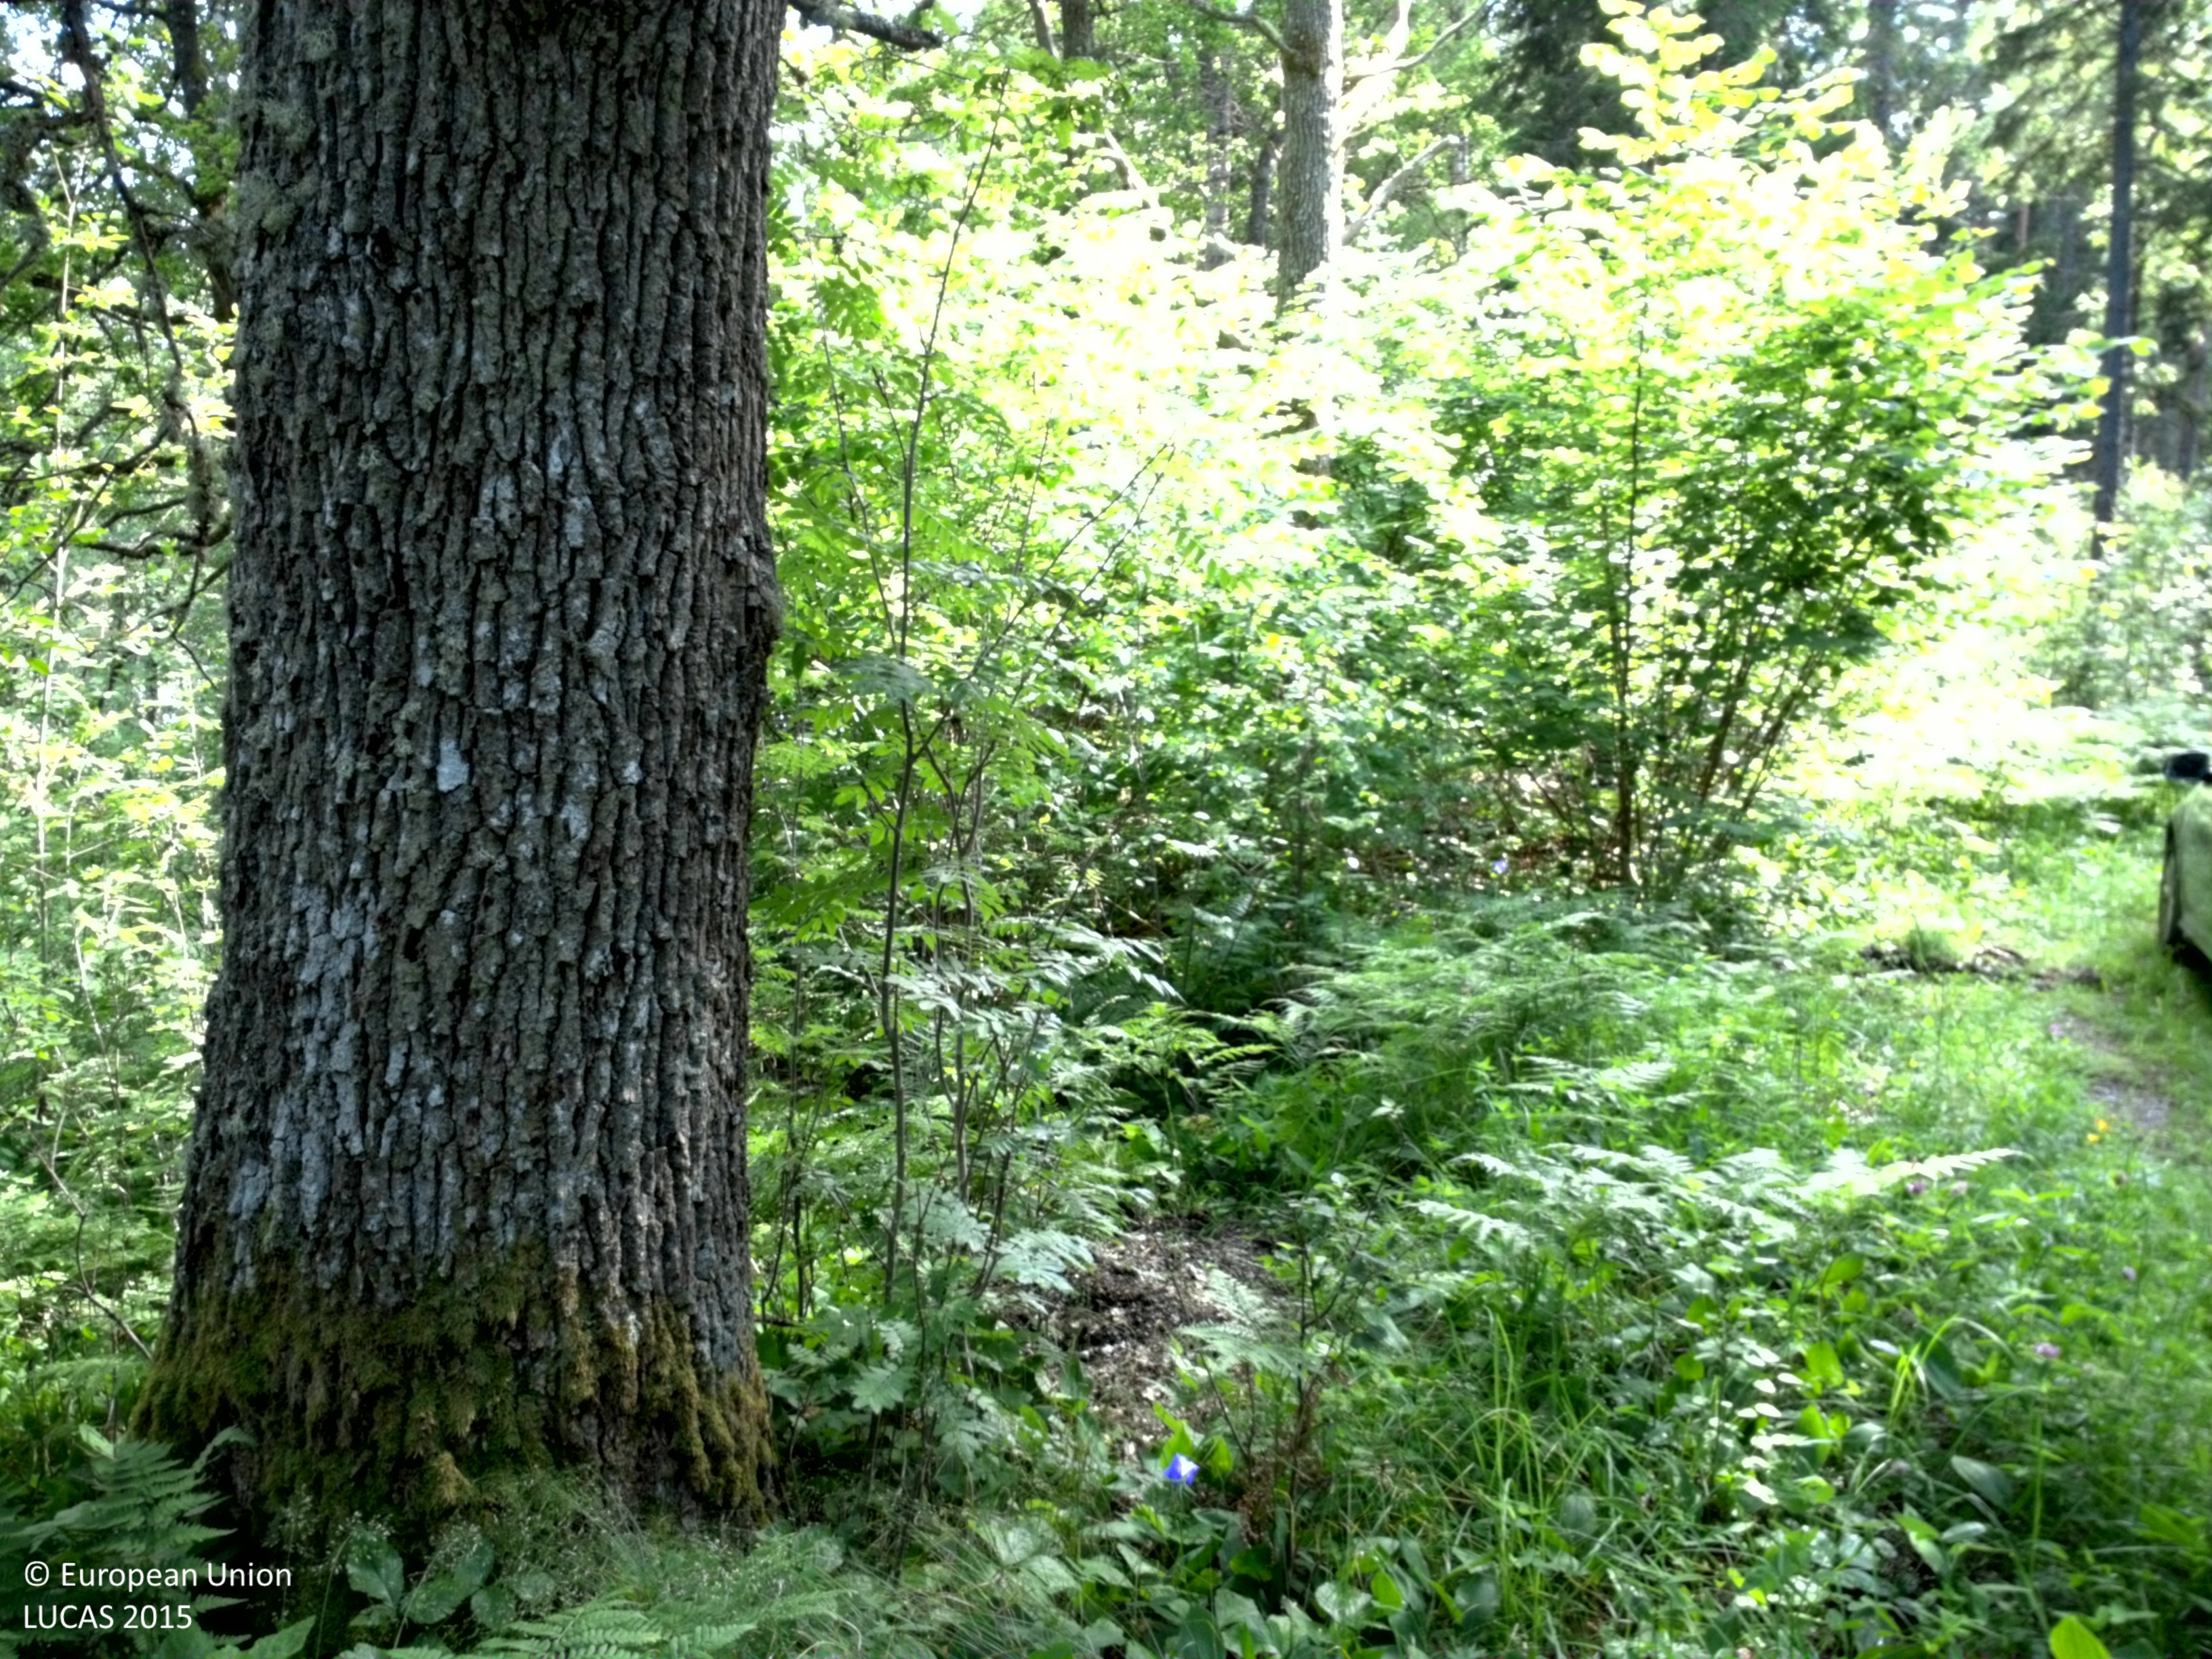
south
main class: Woodland
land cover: Broadleaved woodland
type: hemiboreal forest and nemoral coniferous forest and mixed broadleaved-coniferous forest
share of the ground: 50 - 75 %
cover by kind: broadleaved forest trees 60 %, herbaceous plants 40 %
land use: Forestry
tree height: > 5 m
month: July
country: SE
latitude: 58.7587
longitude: 15.4386
